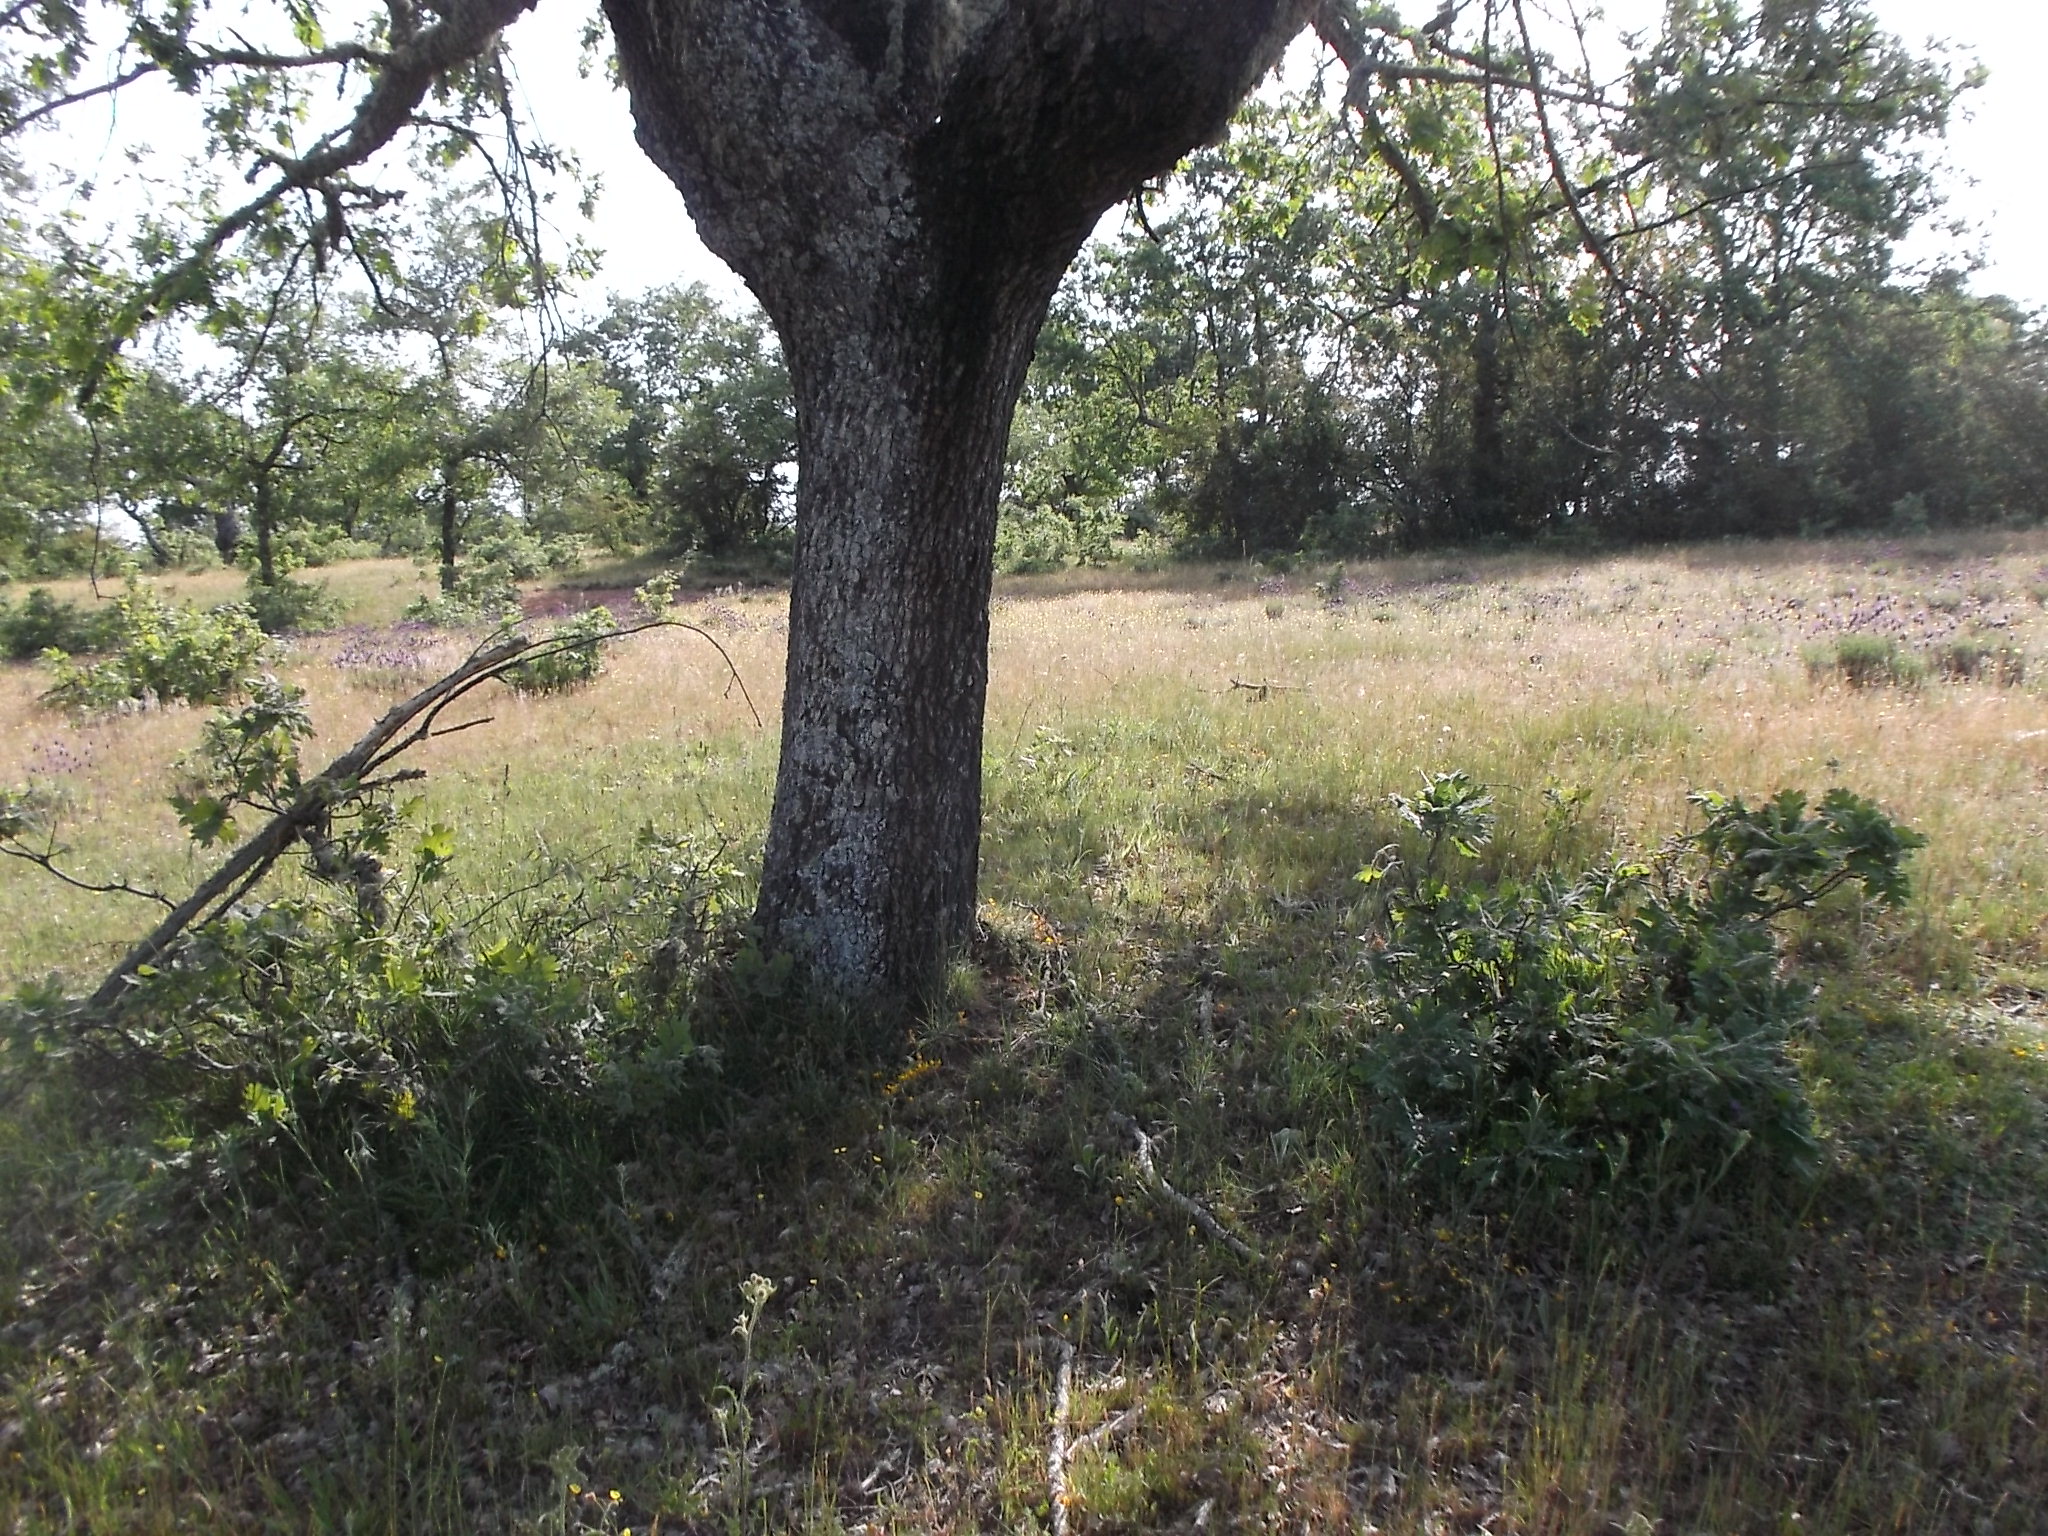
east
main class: Grassland
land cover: Grassland with sparse tree/shrub cover
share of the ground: > 75 %
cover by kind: herbaceous plants 90 %, broadleaved forest trees 5 %, shrubs 5 %
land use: Agriculture (excluding fallow land and kitchen gardens)
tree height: > 5 m
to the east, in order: Grassland with sparse tree/shrub cover; Broadleaved woodland; Grassland without tree/shrub cover; Broadleaved woodland
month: May
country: ES
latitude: 40.9894
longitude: -6.3163
